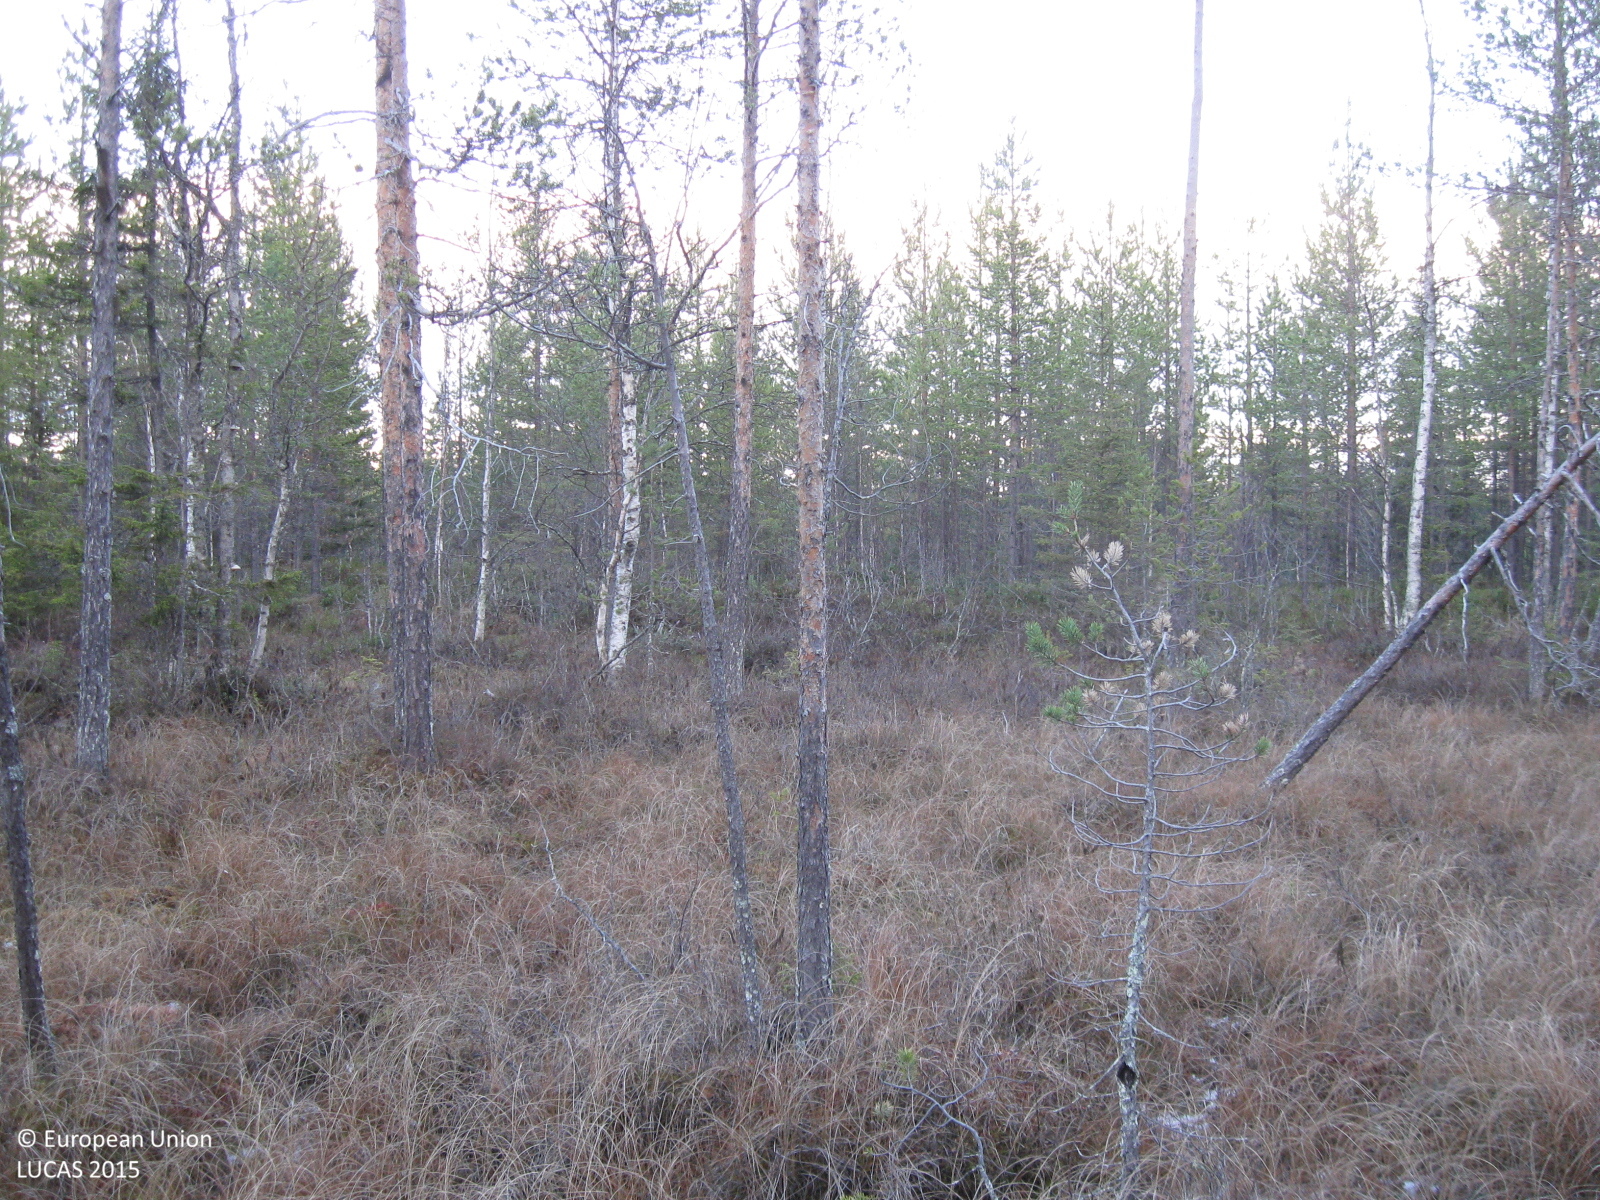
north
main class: Woodland
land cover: Pine dominated coniferous woodland
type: mire and swamp forests
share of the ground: 25 - 50 %
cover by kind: herbaceous plants 50 %, coniferous forest trees 30 %, shrubs 10 %, broadleaved forest trees 5 %, lichens and mosses 5 %
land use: Semi-natural and natural areas not in use
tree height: > 5 m
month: November
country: SE
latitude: 66.0381
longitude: 20.5312
